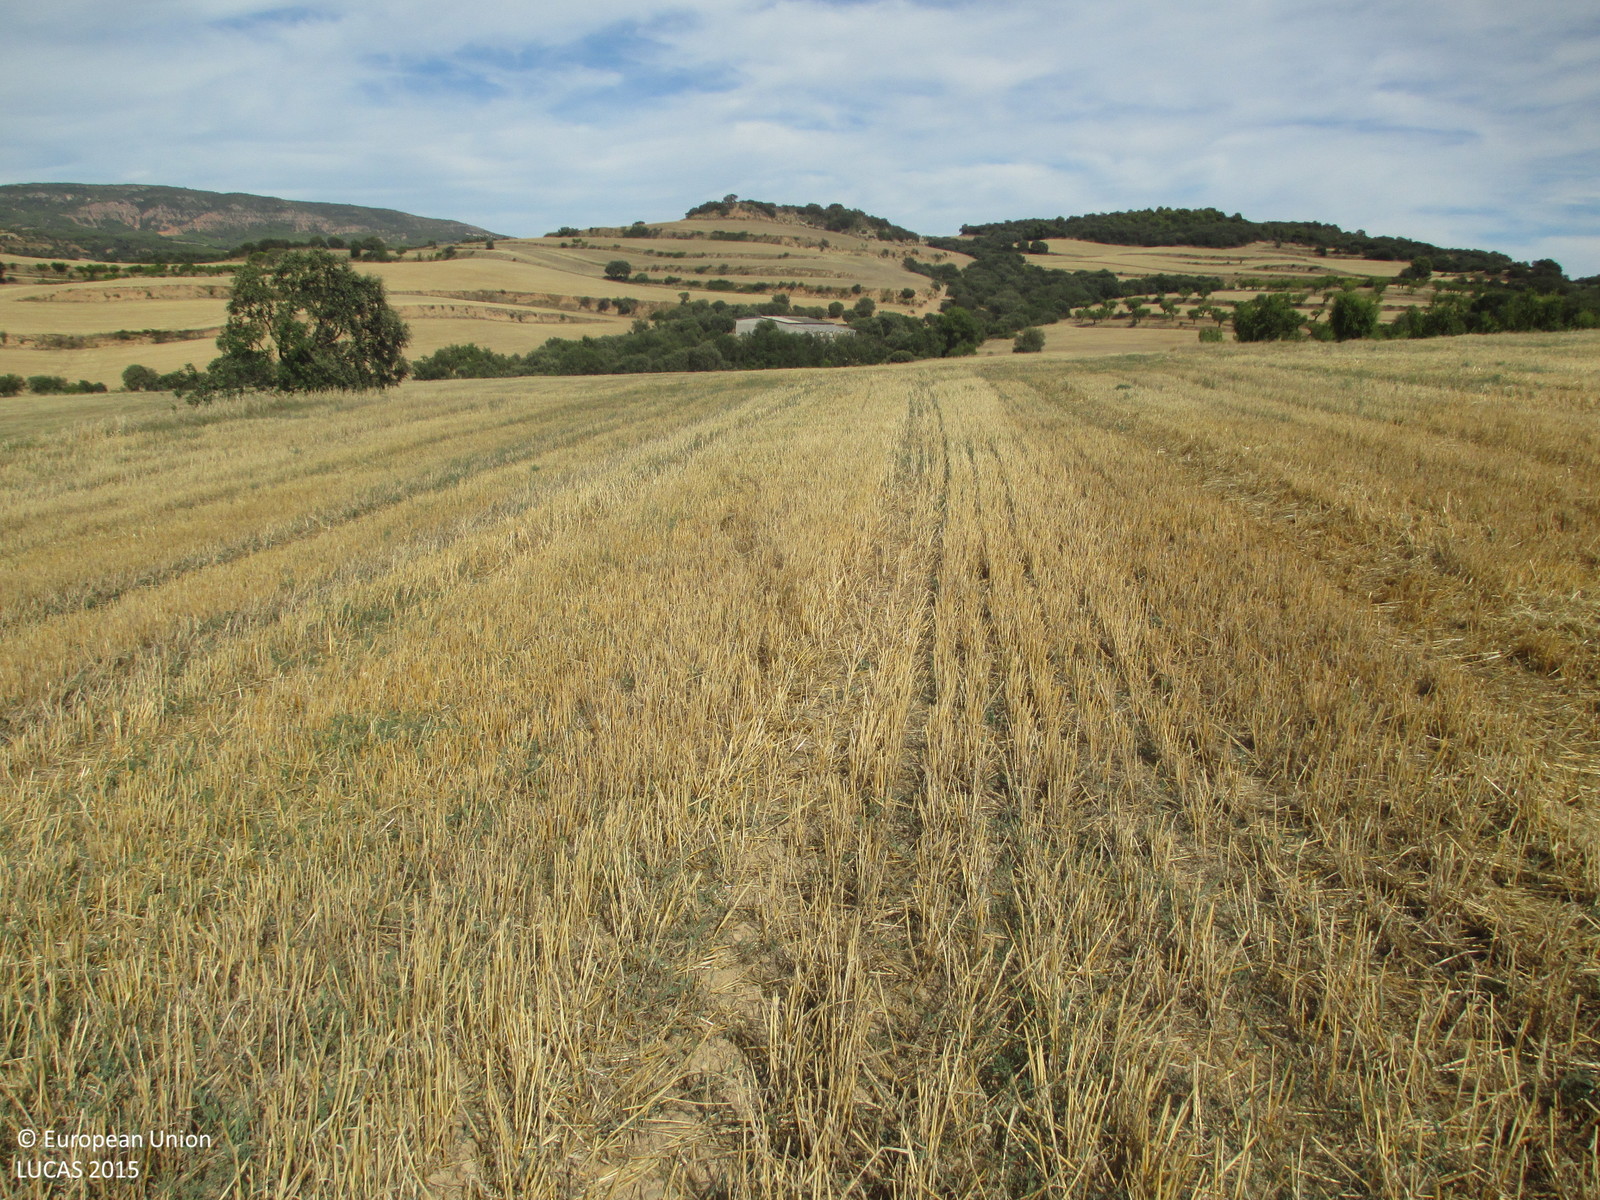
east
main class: Cropland
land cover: Barley
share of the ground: < 10 %
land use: Agriculture (excluding fallow land and kitchen gardens)
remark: Harvested field
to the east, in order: Barley; Groves; Barley; Shruby margins; Tracks; Broadleaved woodland; Rivers and streams; Broadleaved woodland
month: July
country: ES
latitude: 41.9577
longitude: 0.3681
